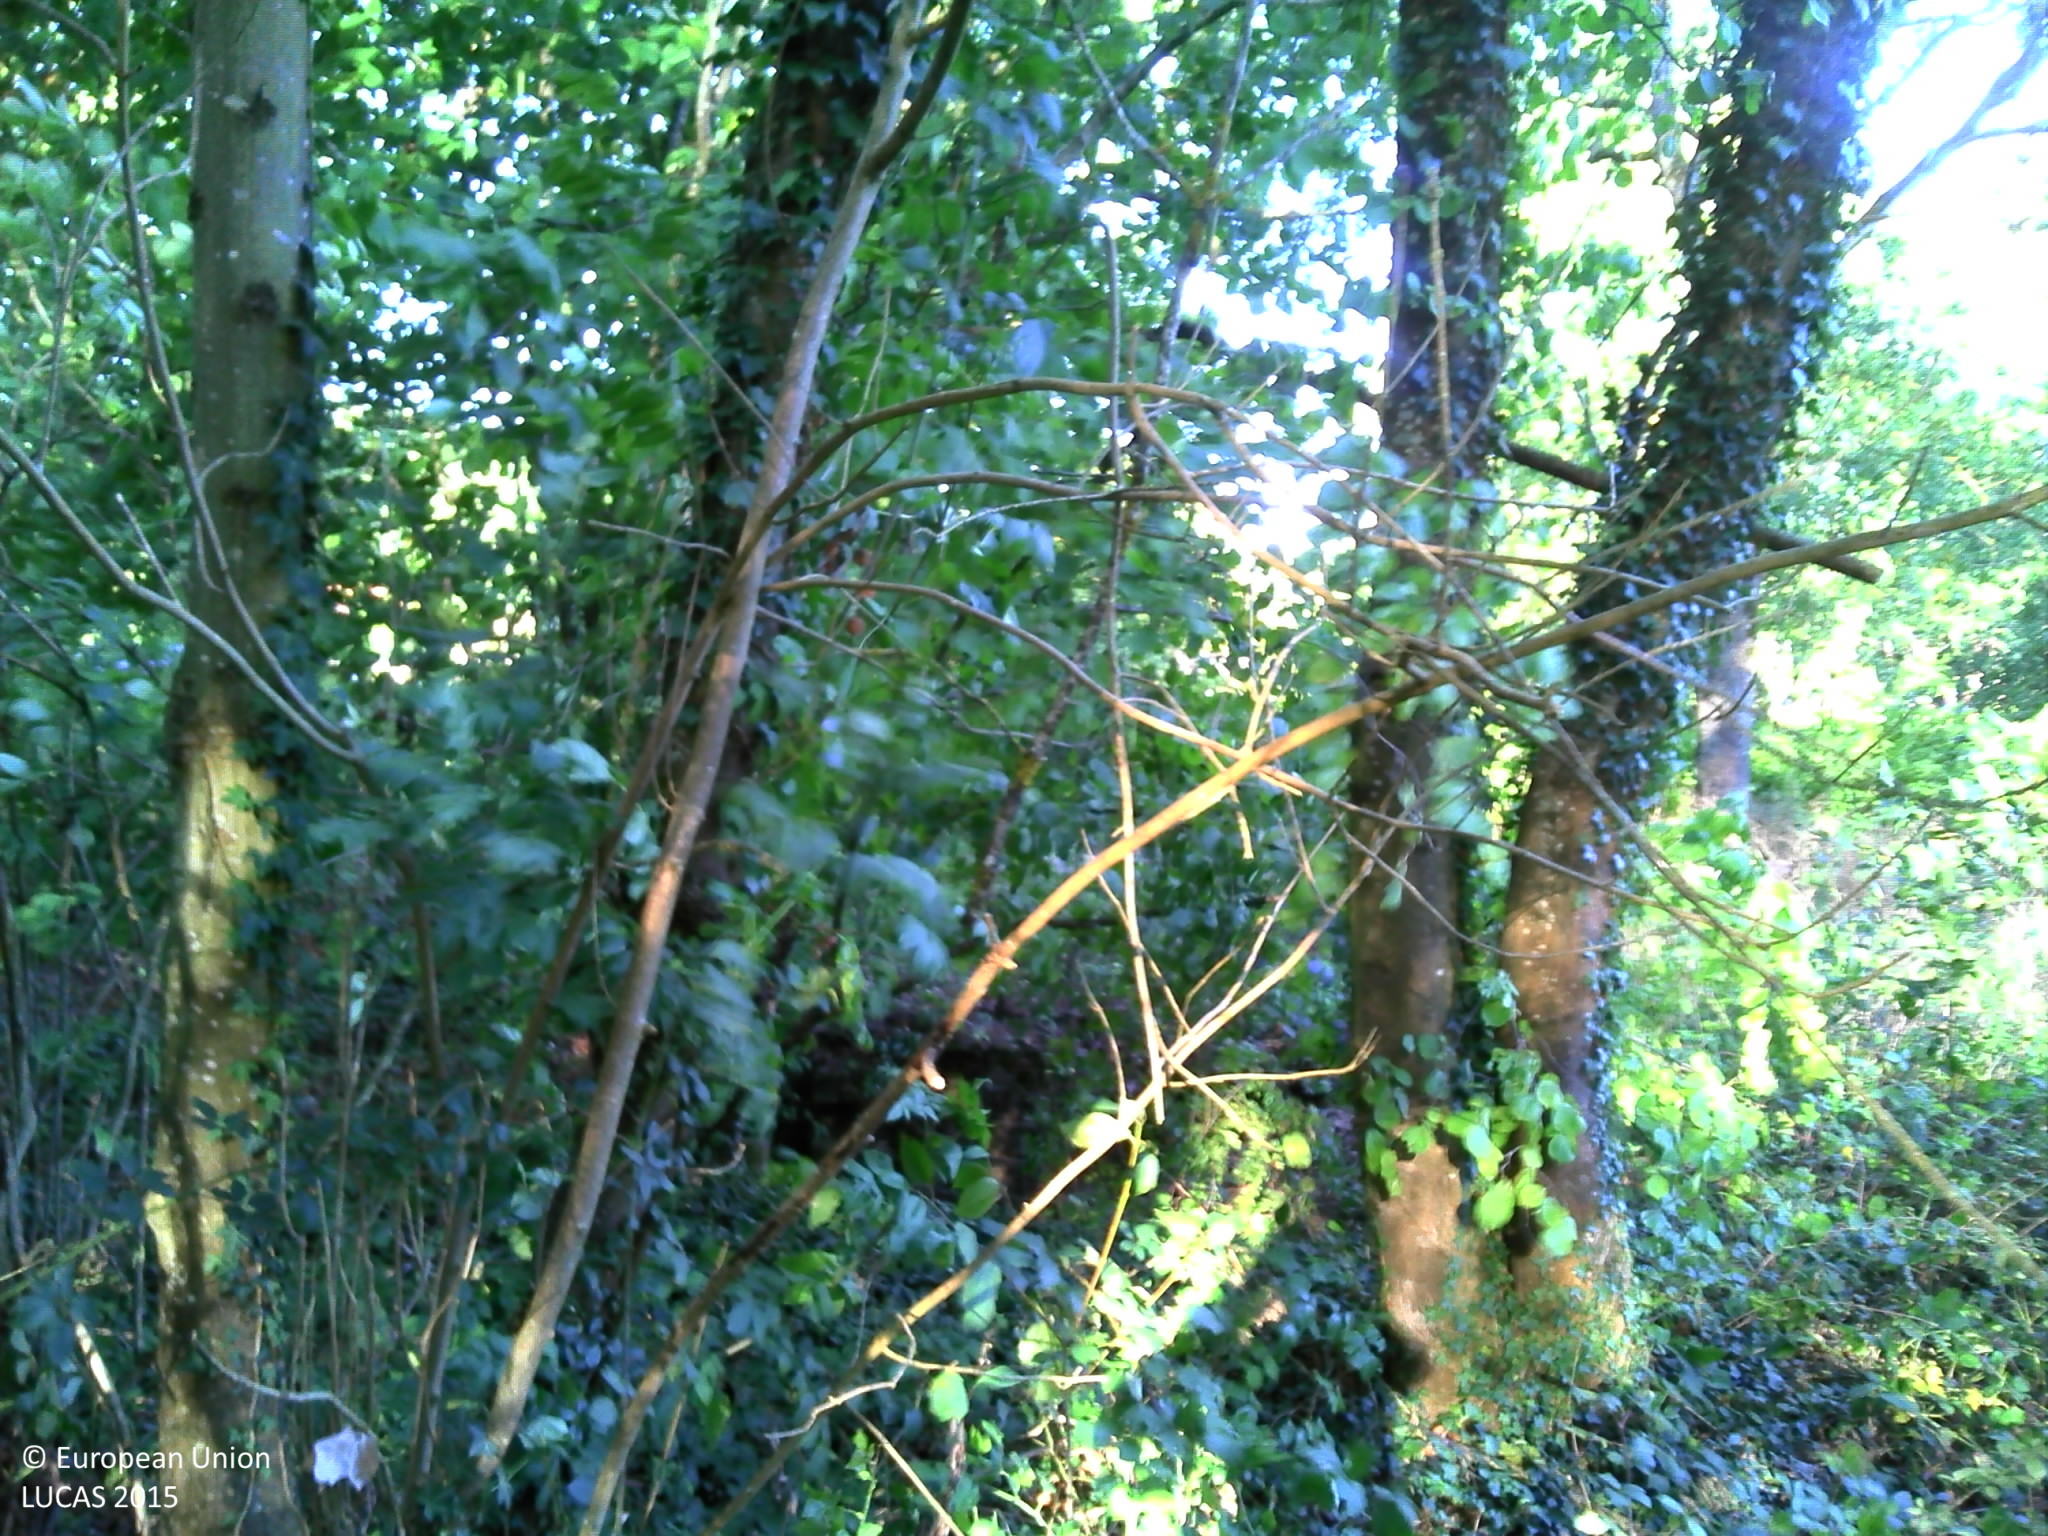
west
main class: Woodland
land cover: Broadleaved woodland
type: floodplain forest
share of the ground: > 75 %
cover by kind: broadleaved forest trees 85 %, herbaceous plants 10 %, consolidated bare surface 5 %
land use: Semi-natural and natural areas not in use
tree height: > 5 m
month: September
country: FR
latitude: 48.4123
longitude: 6.2580
